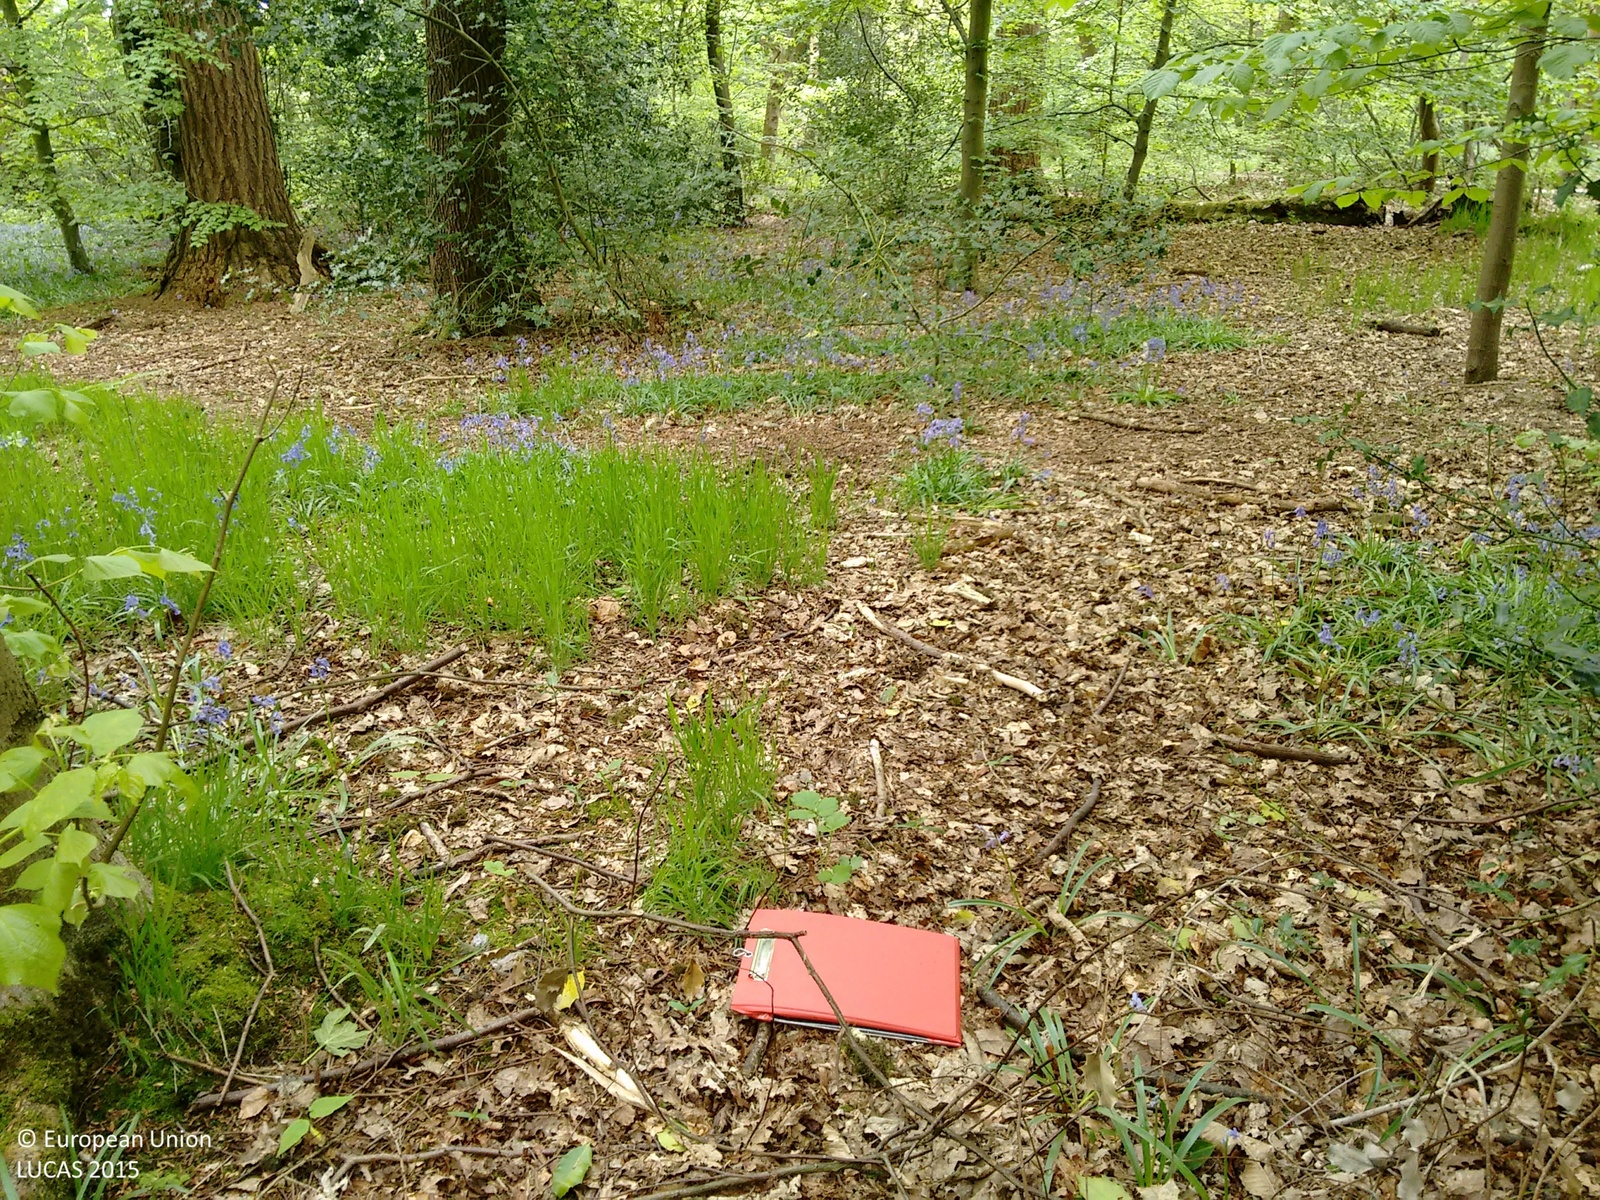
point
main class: Woodland
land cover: Broadleaved woodland
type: mesophytic deciduous forest
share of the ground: > 75 %
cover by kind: broadleaved forest trees 100 %
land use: Semi-natural and natural areas not in use
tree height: > 5 m
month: May
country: GB
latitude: 53.3415
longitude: -1.5103
